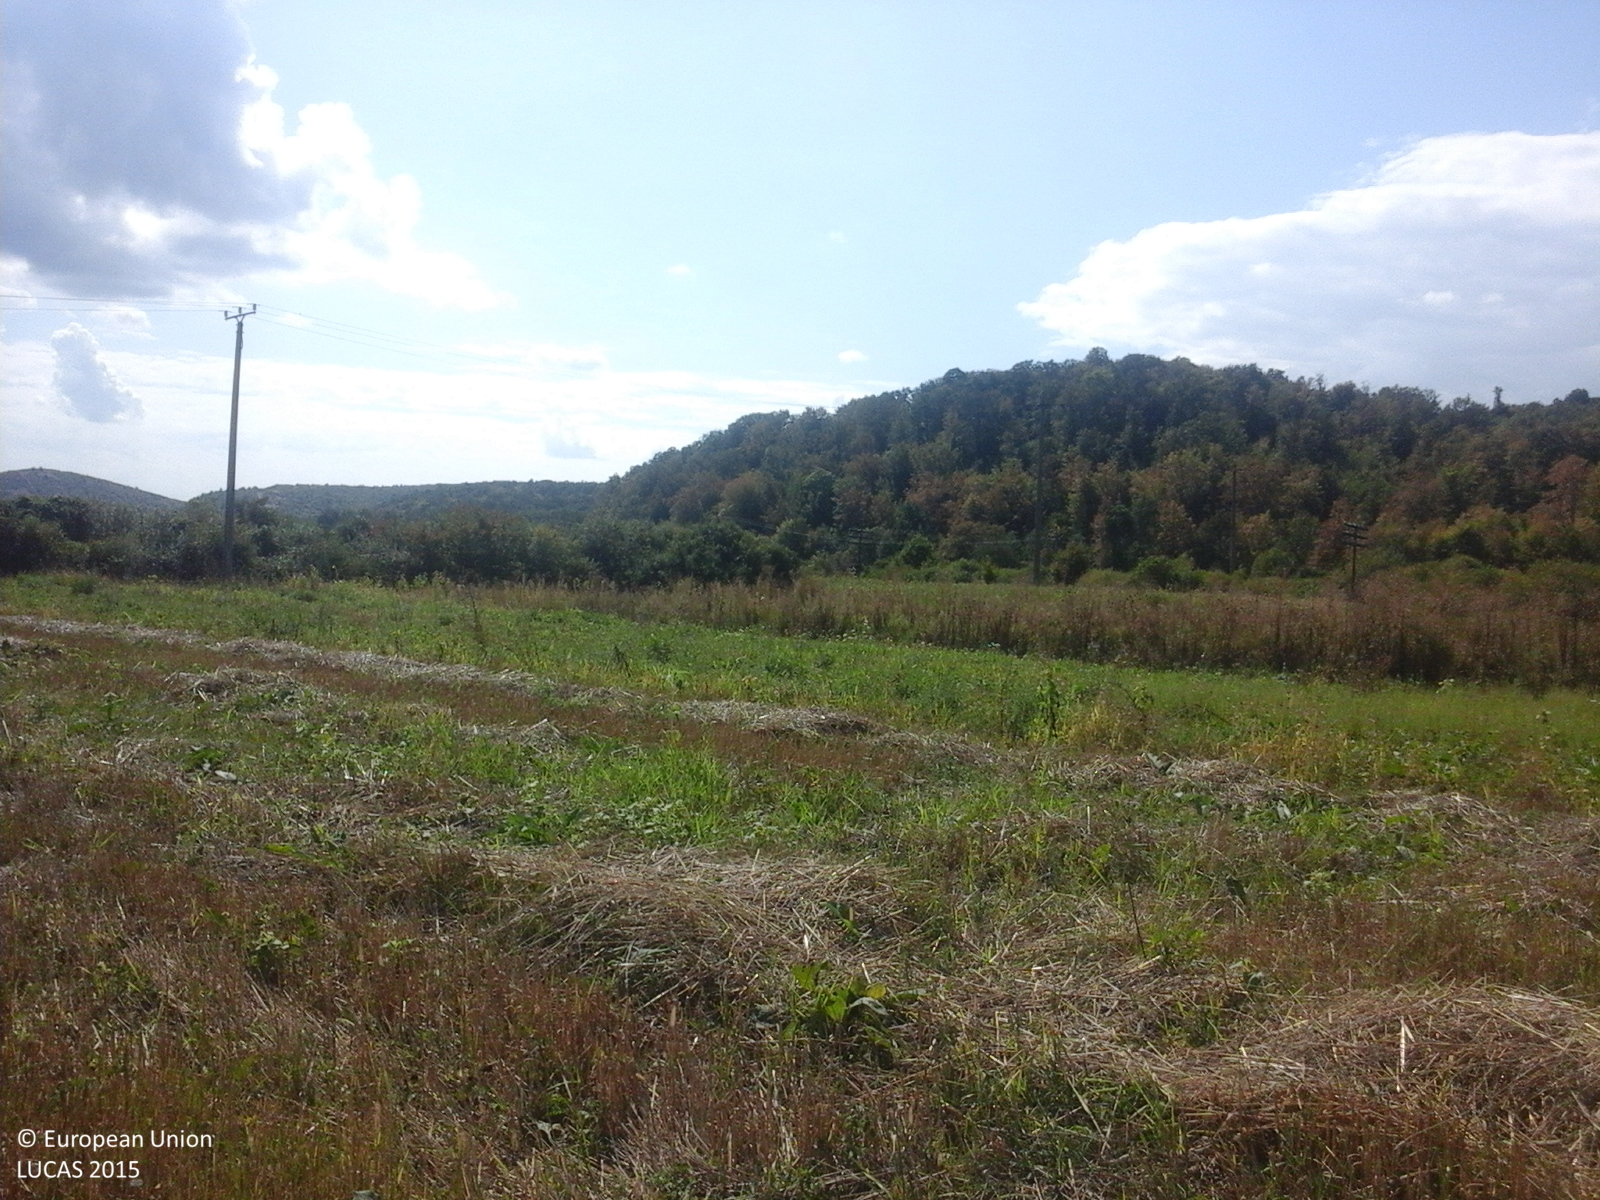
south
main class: Cropland
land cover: Common wheat
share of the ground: > 75 %
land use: Agriculture (excluding fallow land and kitchen gardens)
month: September
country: RO
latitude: 47.8554
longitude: 23.2632
